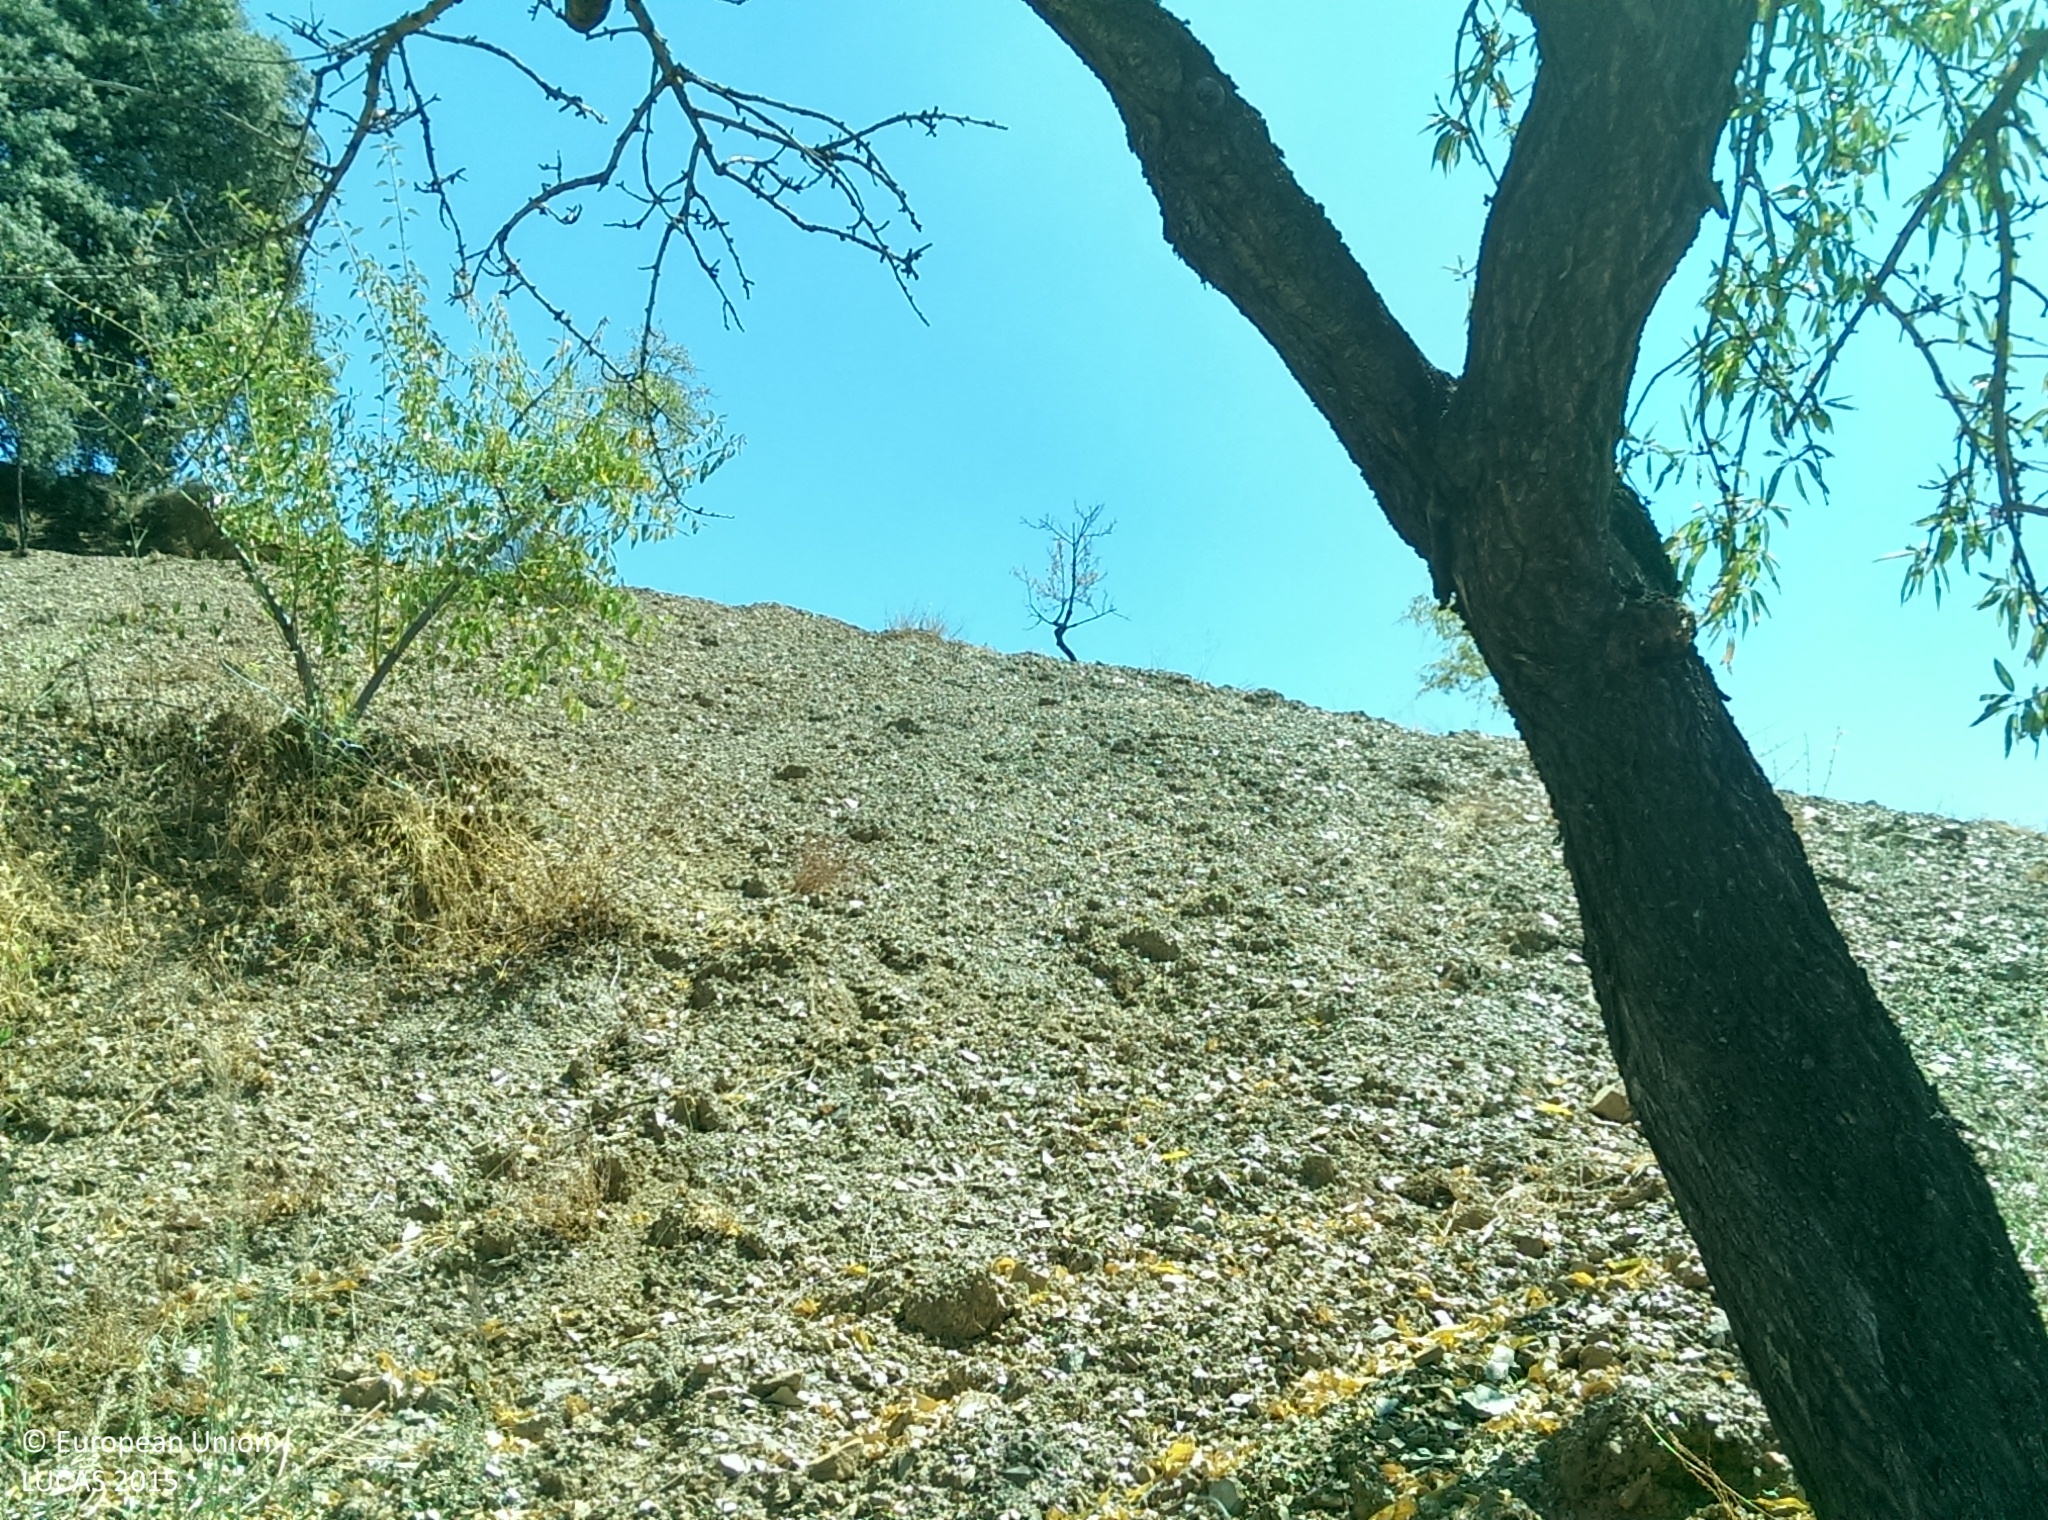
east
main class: Cropland
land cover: Nuts trees
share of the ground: 25 - 50 %
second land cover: Spontaneously vegetated surfaces
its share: 25 - 50 %
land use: Agriculture (excluding fallow land and kitchen gardens)
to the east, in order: Nuts trees; Spontaneously vegetated surfaces; Tracks; Nuts trees; Broadleaved woodland; Nuts trees; Tracks; Nuts trees; Tracks; Grassland with sparse tree/shrub cover; Nuts trees; Grassland with sparse tree/shrub cover; Other fruit trees and berries
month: August
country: ES
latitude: 36.8295
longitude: -3.1539
